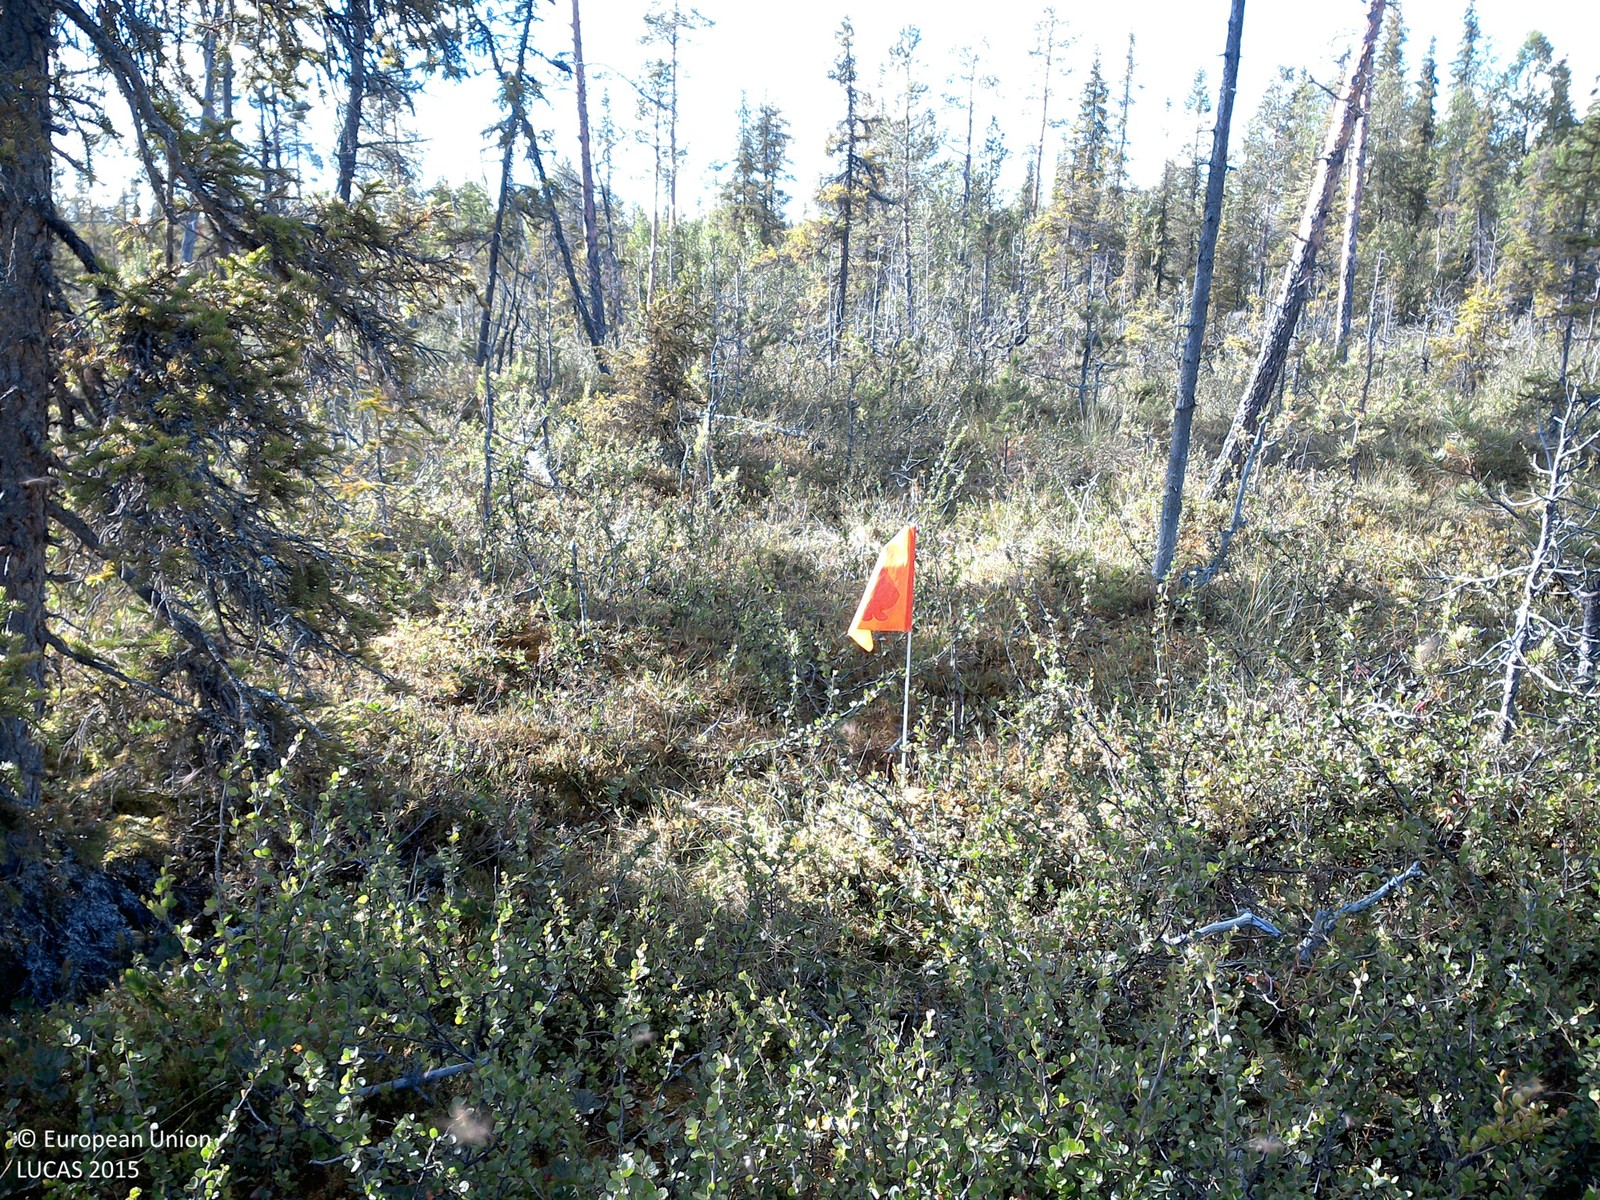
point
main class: Woodland
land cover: Pine dominated coniferous woodland
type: boreal forest
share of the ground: 10 - 25 %
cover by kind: shrubs 75 %, coniferous forest trees 15 %, lichens and mosses 10 %
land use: Semi-natural and natural areas not in use
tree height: > 5 m
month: July
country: SE
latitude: 67.7224
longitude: 21.1251
